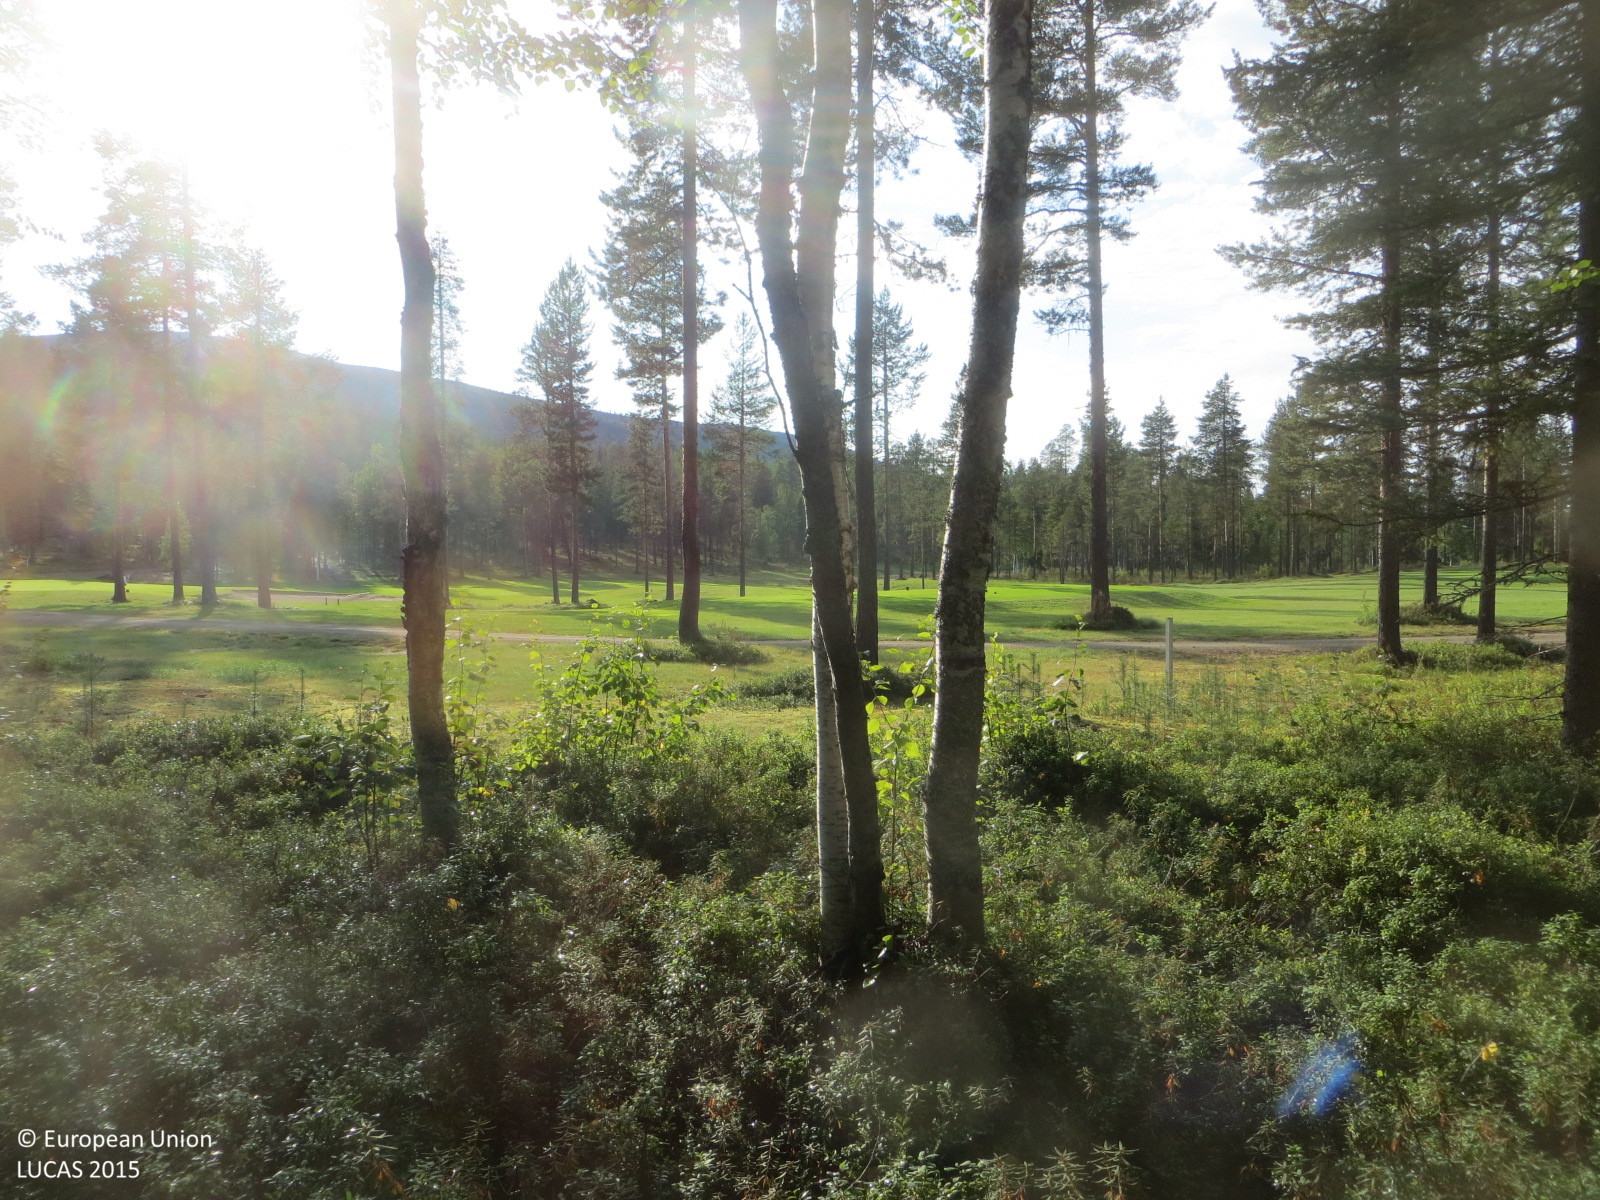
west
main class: Woodland
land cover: Other mixed woodland
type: boreal forest
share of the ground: 50 - 75 %
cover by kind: shrubs 40 %, coniferous forest trees 30 %, broadleaved forest trees 30 %
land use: Forestry
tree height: > 5 m
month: August
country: FI
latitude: 67.7948
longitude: 24.9000
